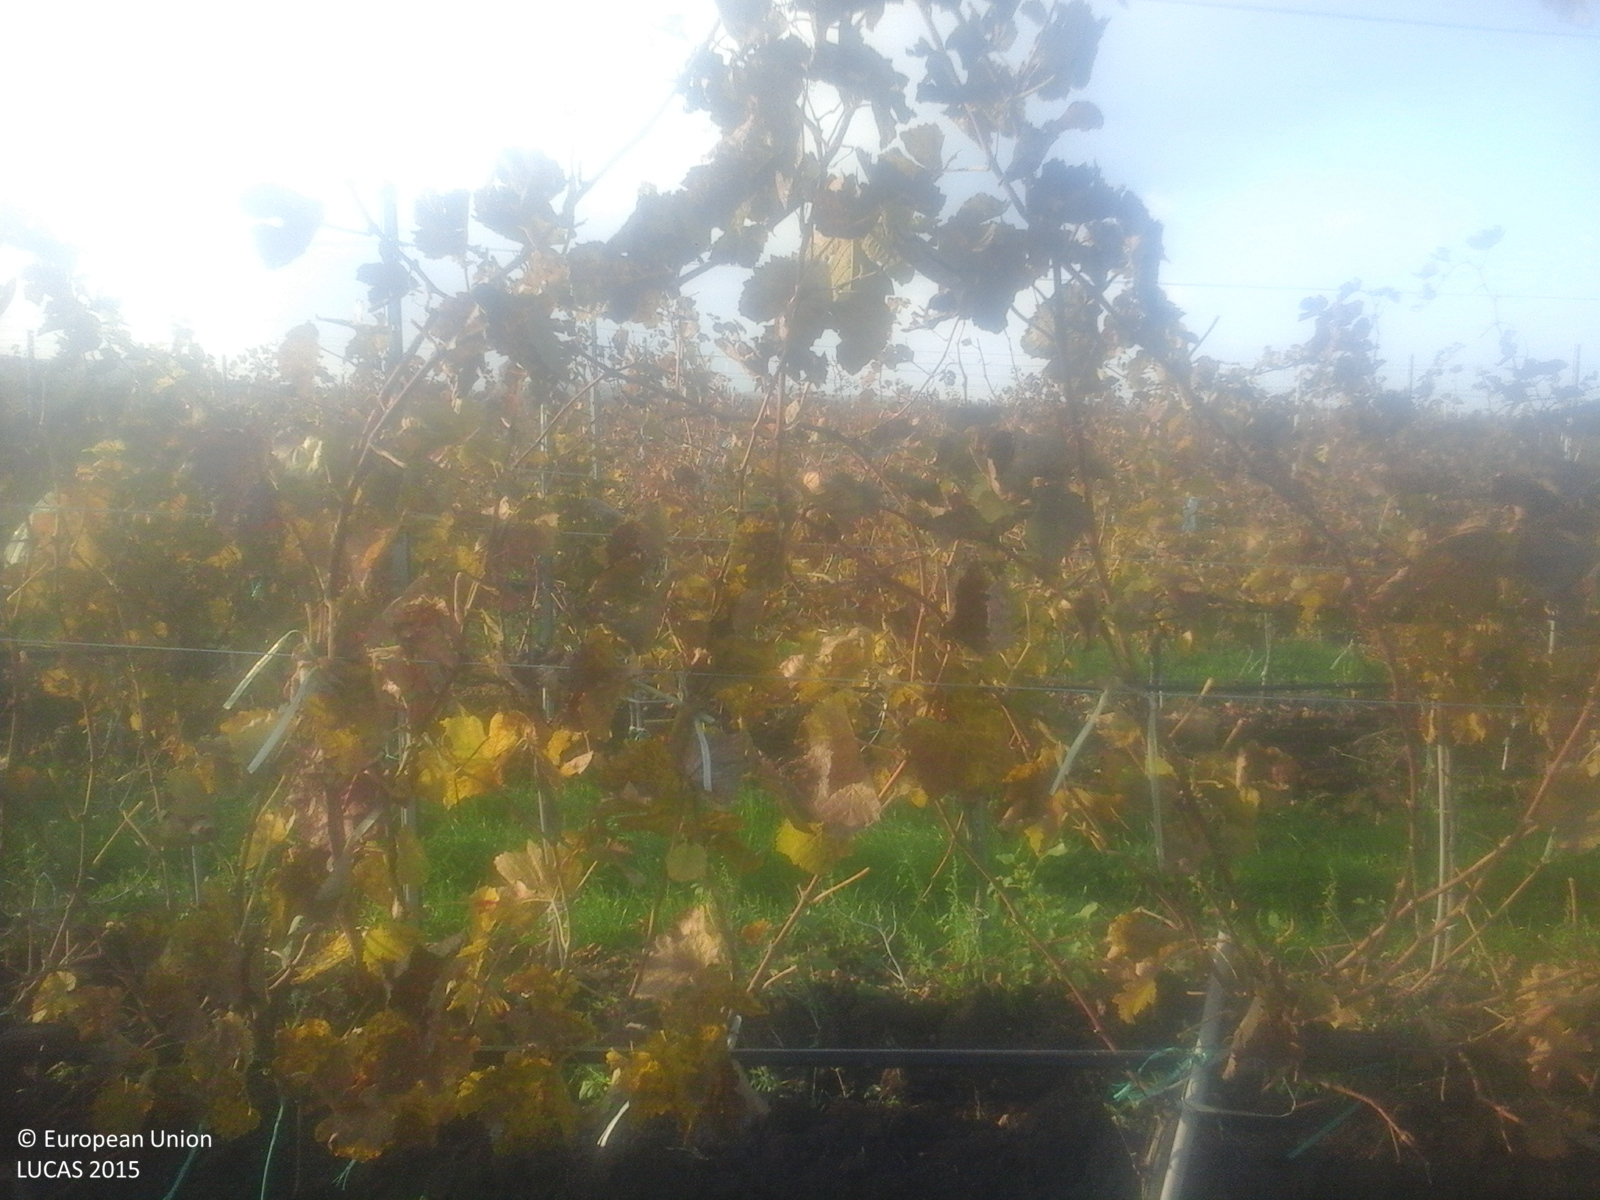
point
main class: Cropland
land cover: Vineyards
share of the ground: > 75 %
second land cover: Other bare soil
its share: > 75 %
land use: Agriculture (excluding fallow land and kitchen gardens)
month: October
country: RO
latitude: 45.3849
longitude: 26.9833
